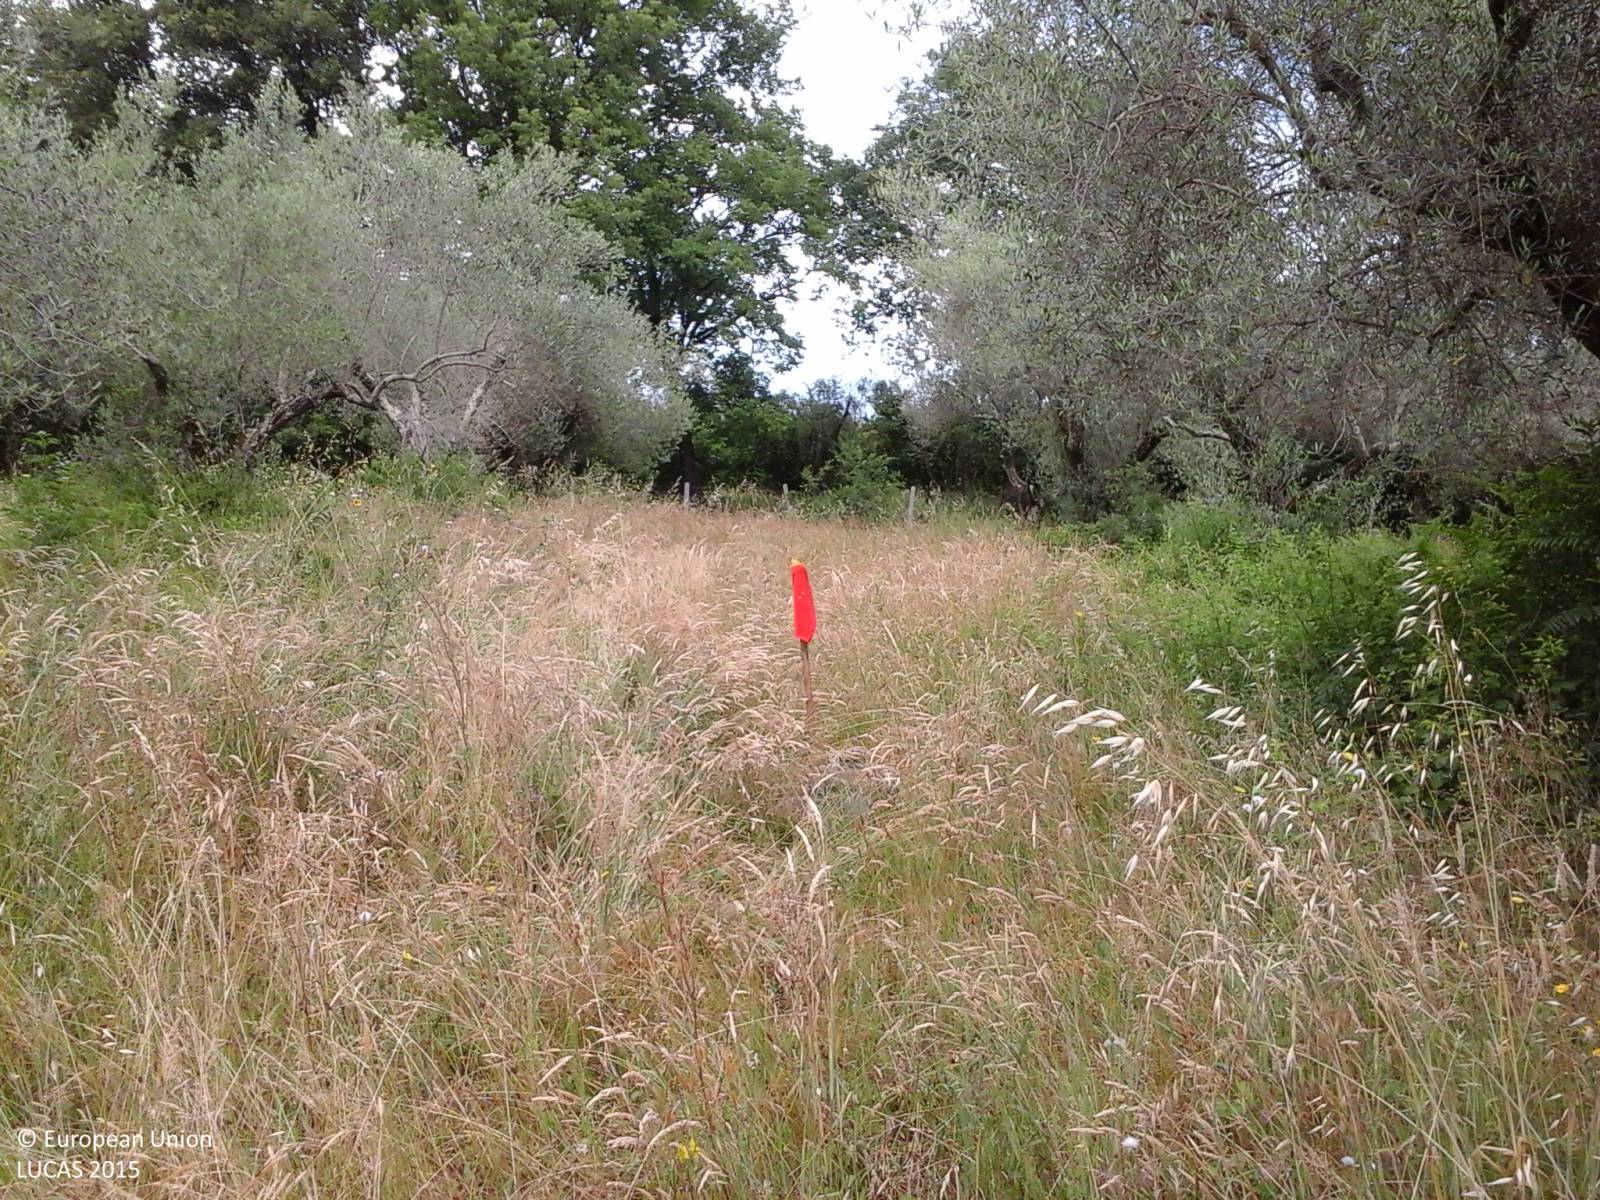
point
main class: Cropland
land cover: Olive groves
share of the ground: 50 - 75 %
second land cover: Grassland without tree/shrub cover
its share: > 75 %
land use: Agriculture (excluding fallow land and kitchen gardens)
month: May
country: IT
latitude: 42.2855
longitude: 12.2599
